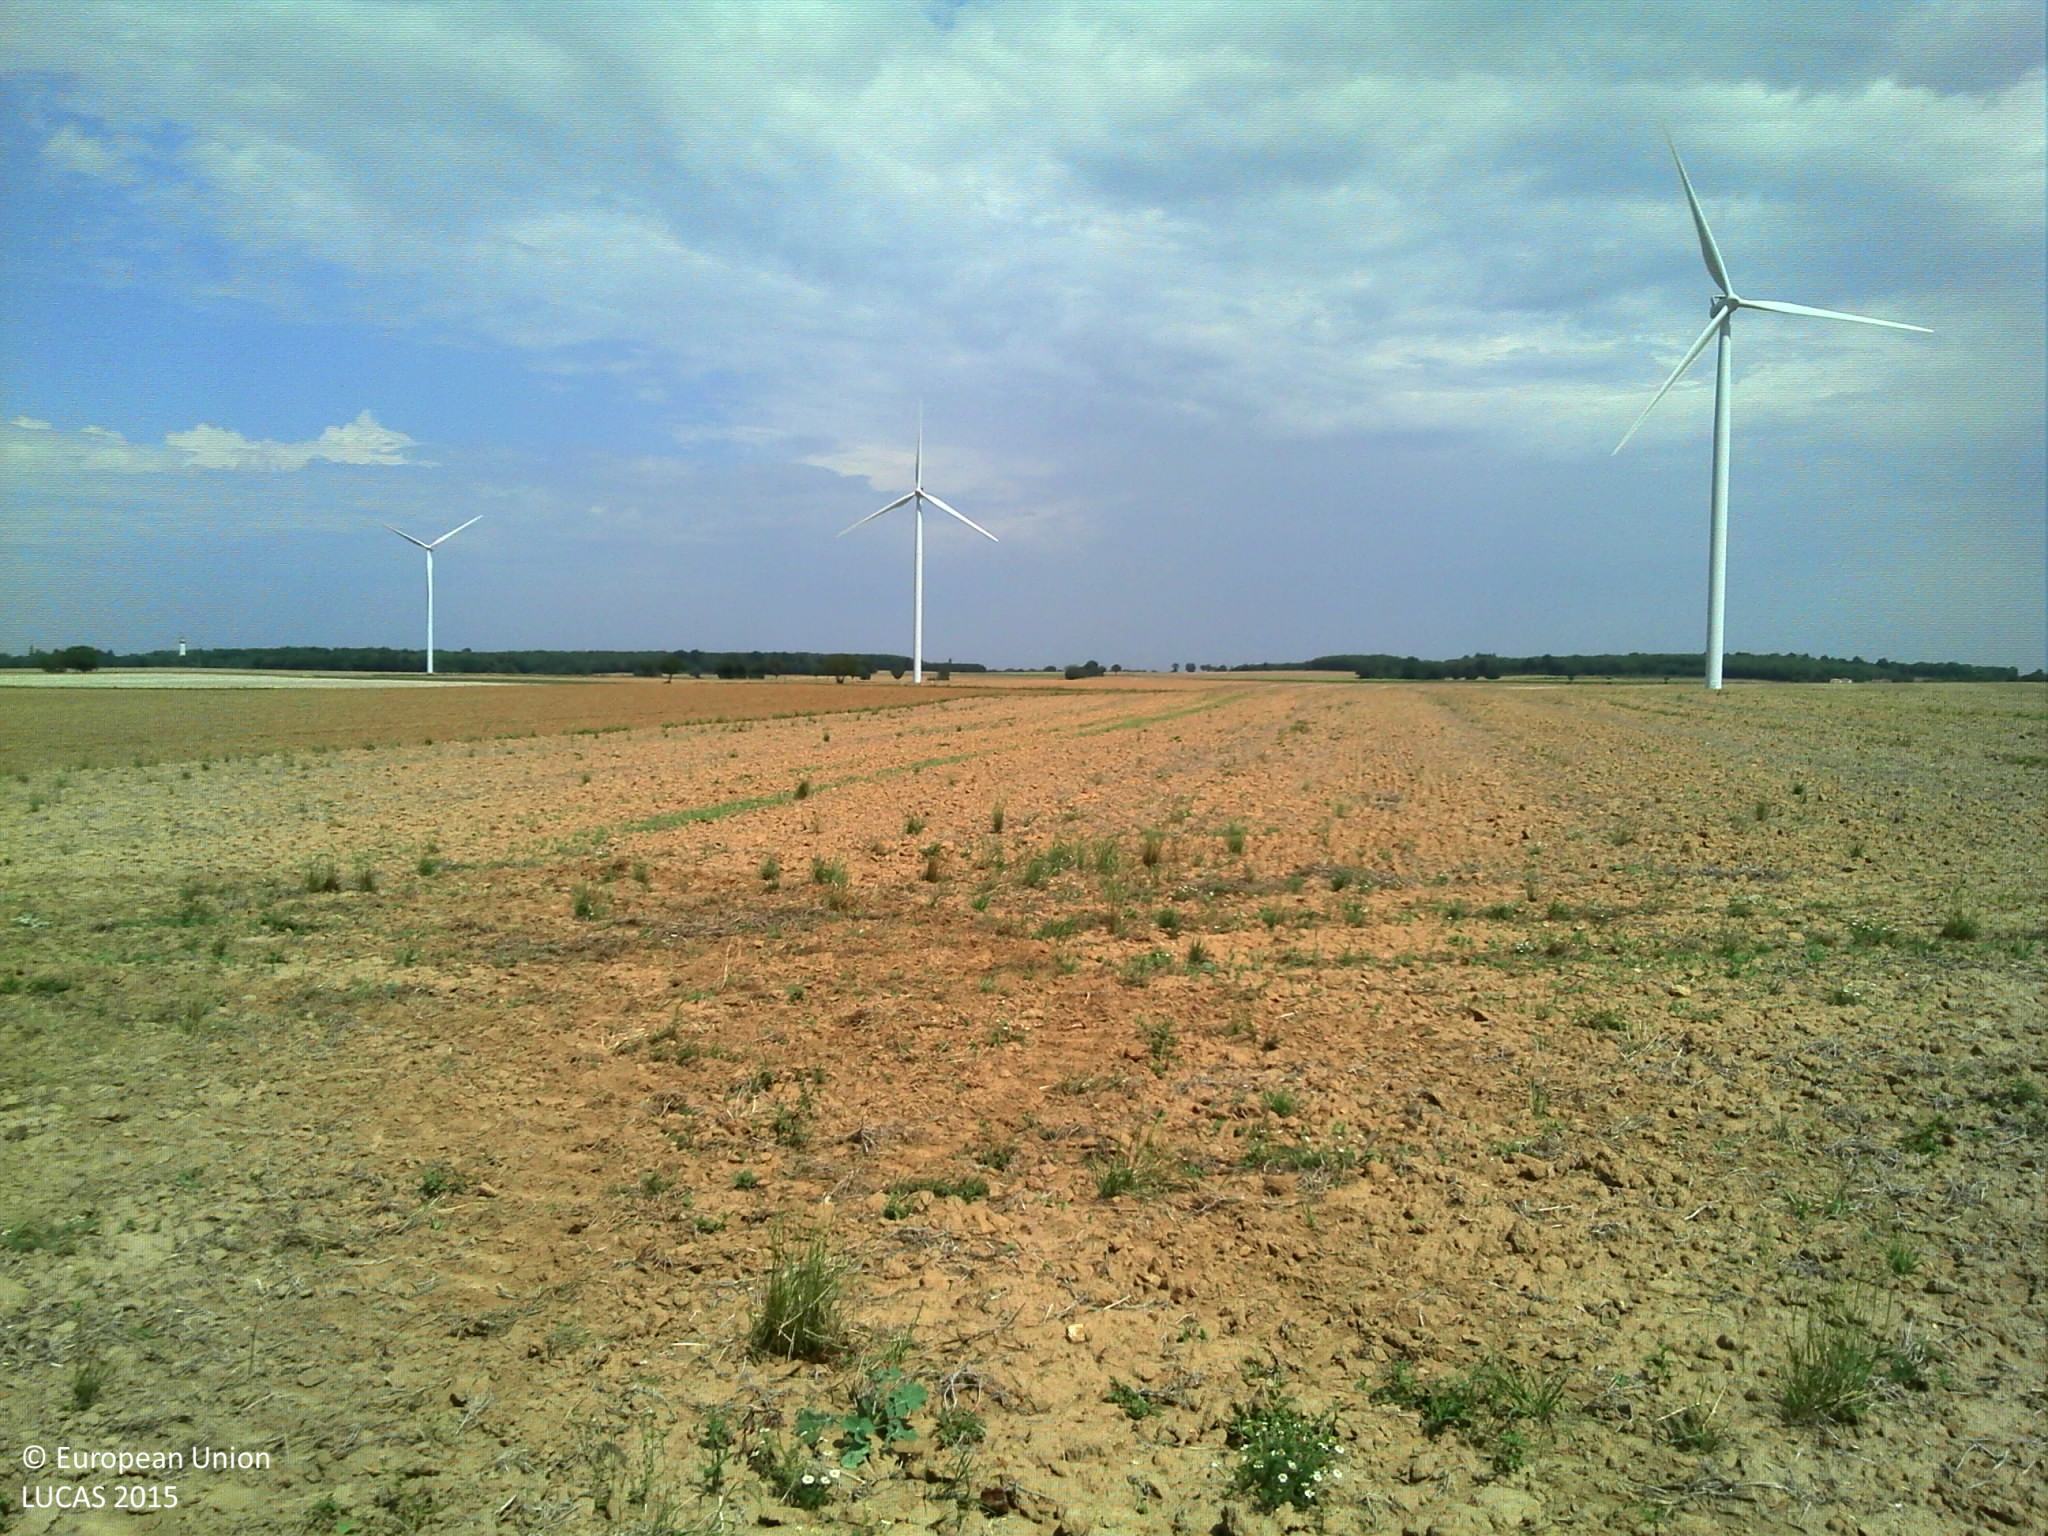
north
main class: Cropland
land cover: Dry pulses
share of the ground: < 10 %
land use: Agriculture (excluding fallow land and kitchen gardens)
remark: Tilled/Sowed
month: August
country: FR
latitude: 46.1058
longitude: 0.2666
